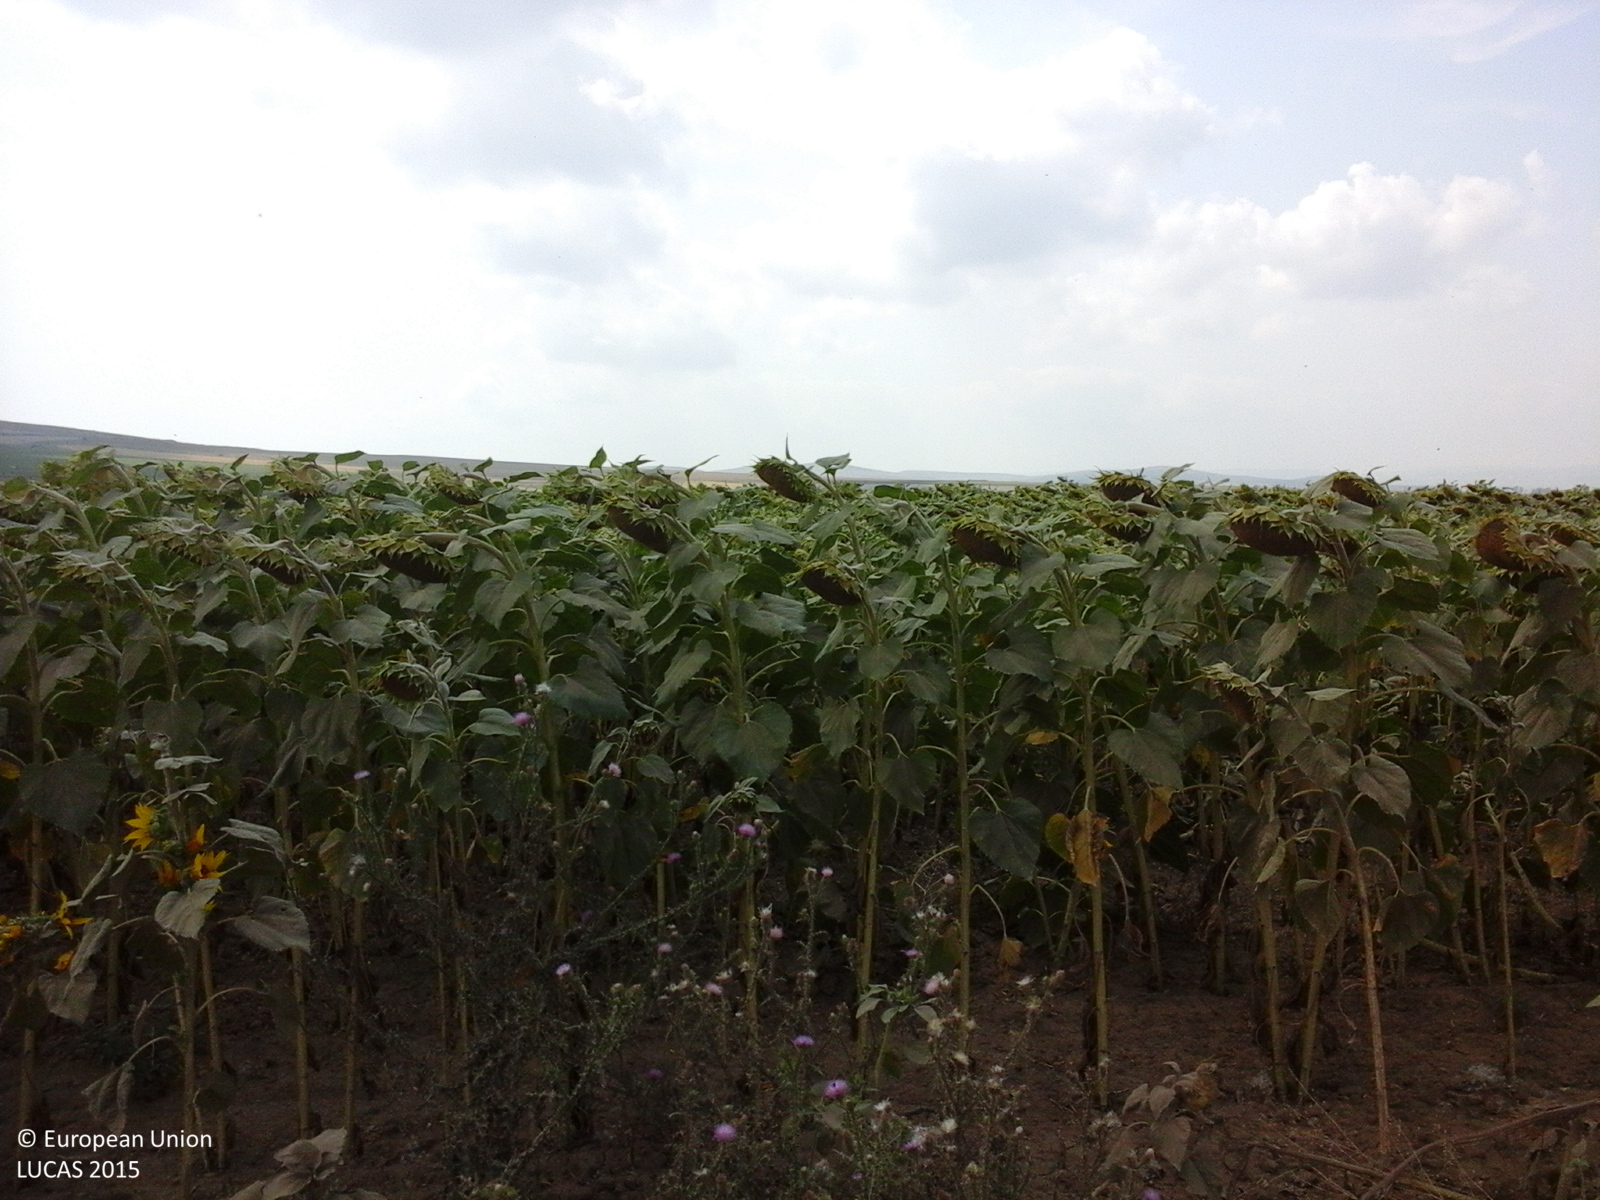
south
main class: Cropland
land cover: Sunflower
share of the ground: > 75 %
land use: Agriculture (excluding fallow land and kitchen gardens)
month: July
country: RO
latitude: 45.0410
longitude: 28.7615
